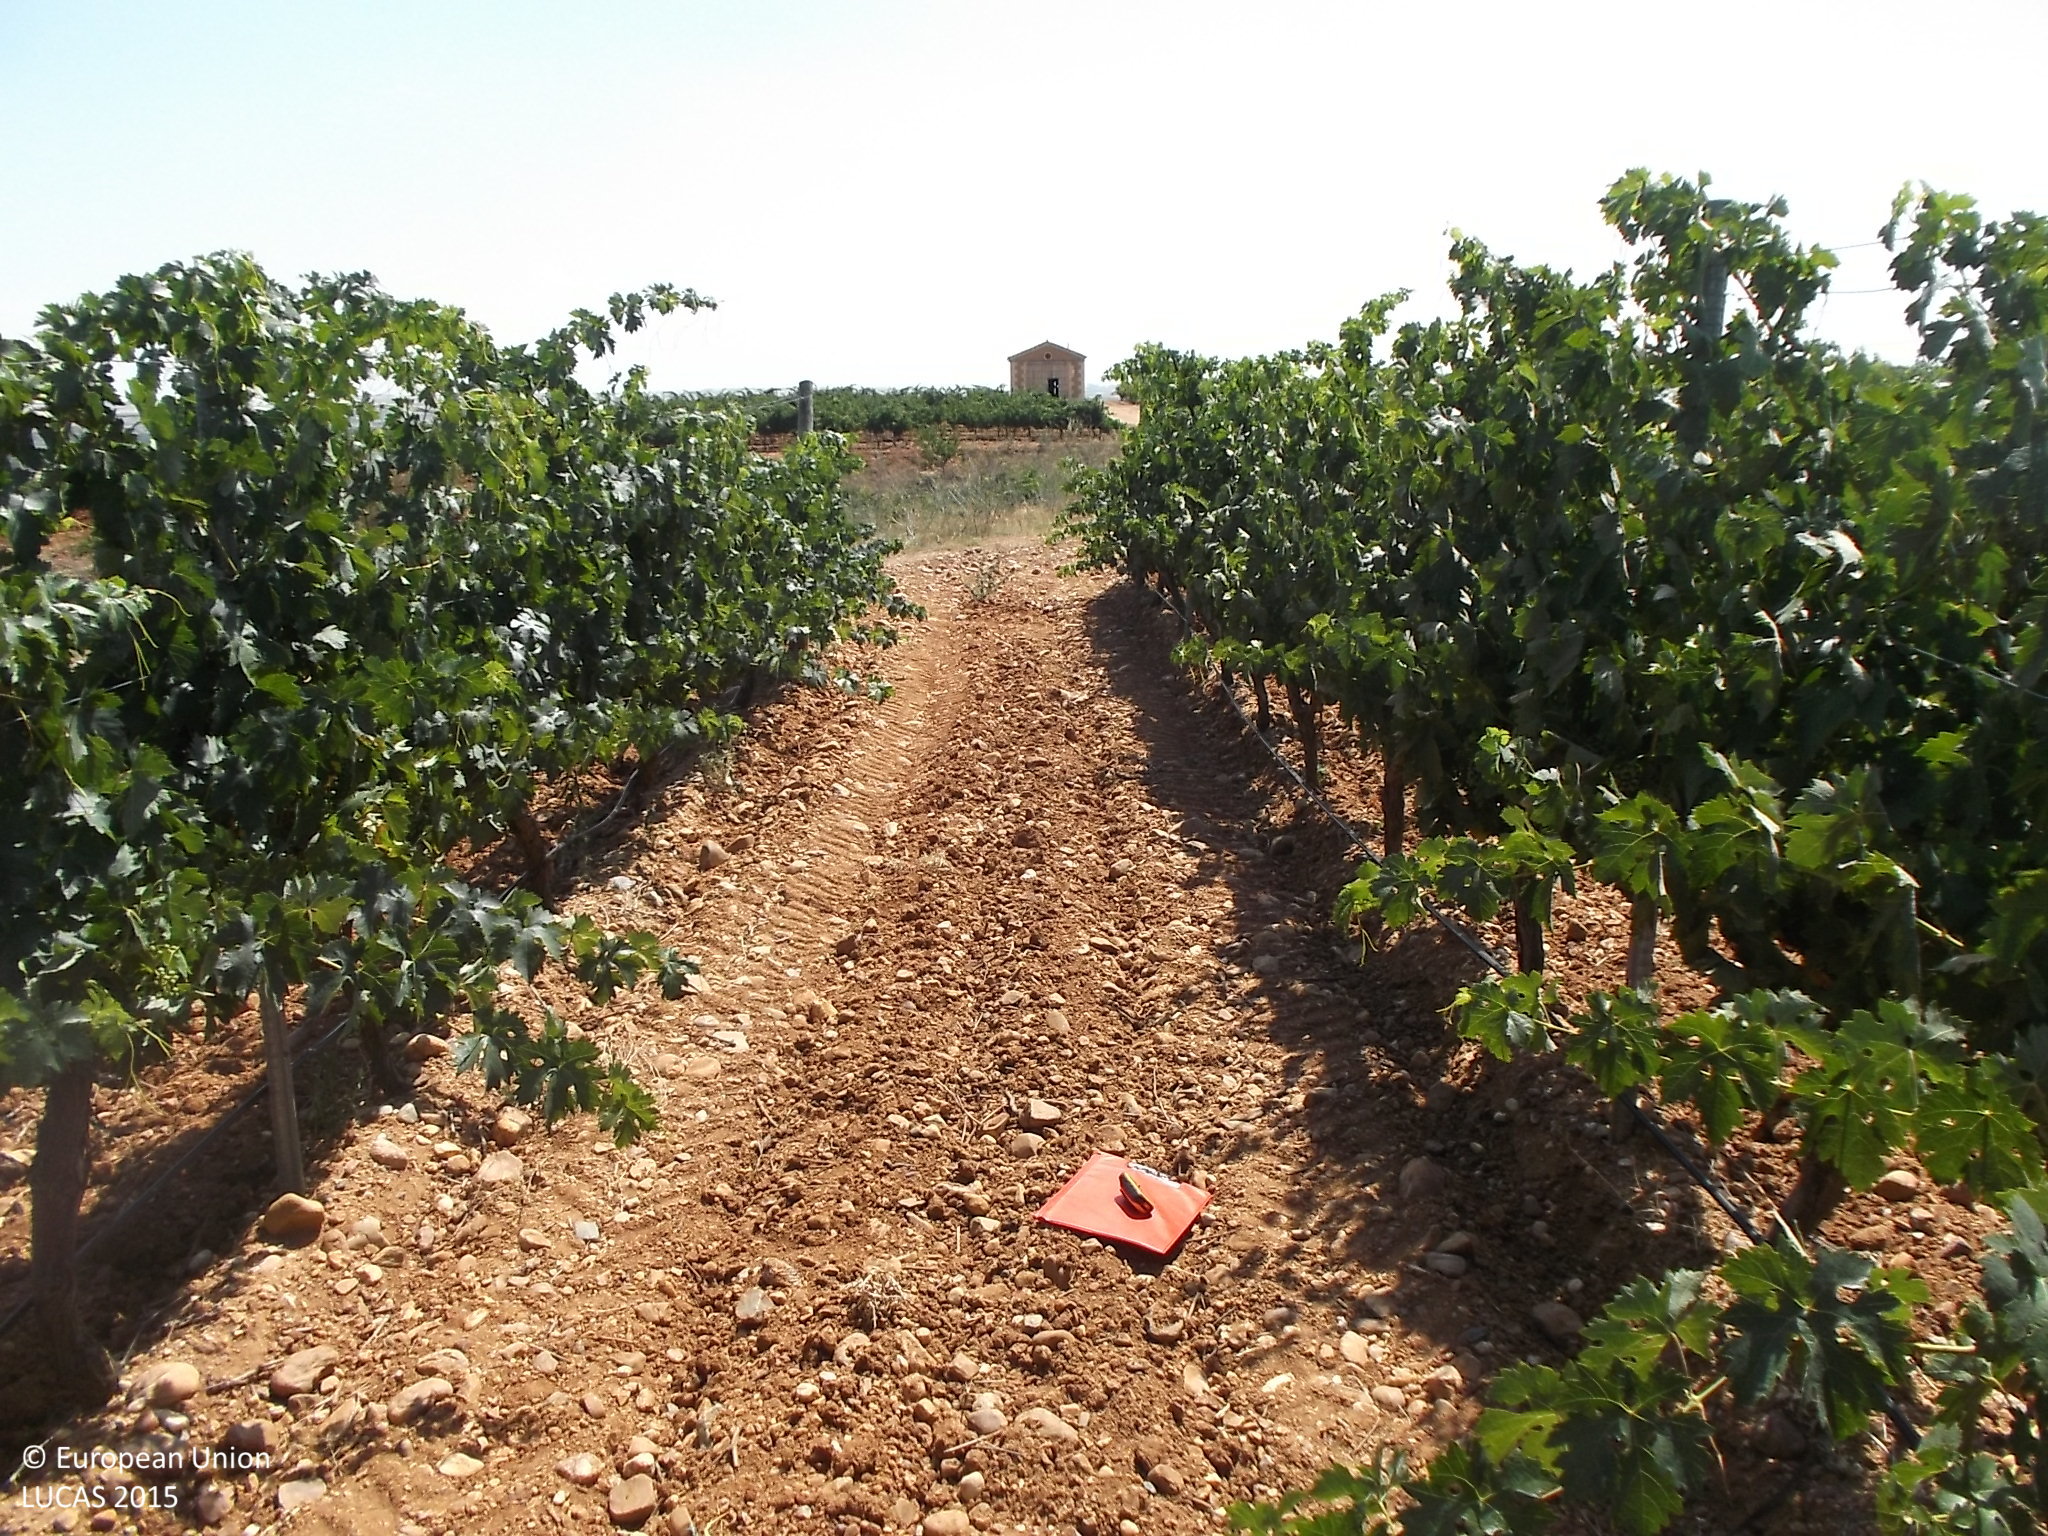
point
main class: Cropland
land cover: Vineyards
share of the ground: 10 - 25 %
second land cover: Other bare soil
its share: > 75 %
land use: Agriculture (excluding fallow land and kitchen gardens)
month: July
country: ES
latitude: 41.4837
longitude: -5.2995
